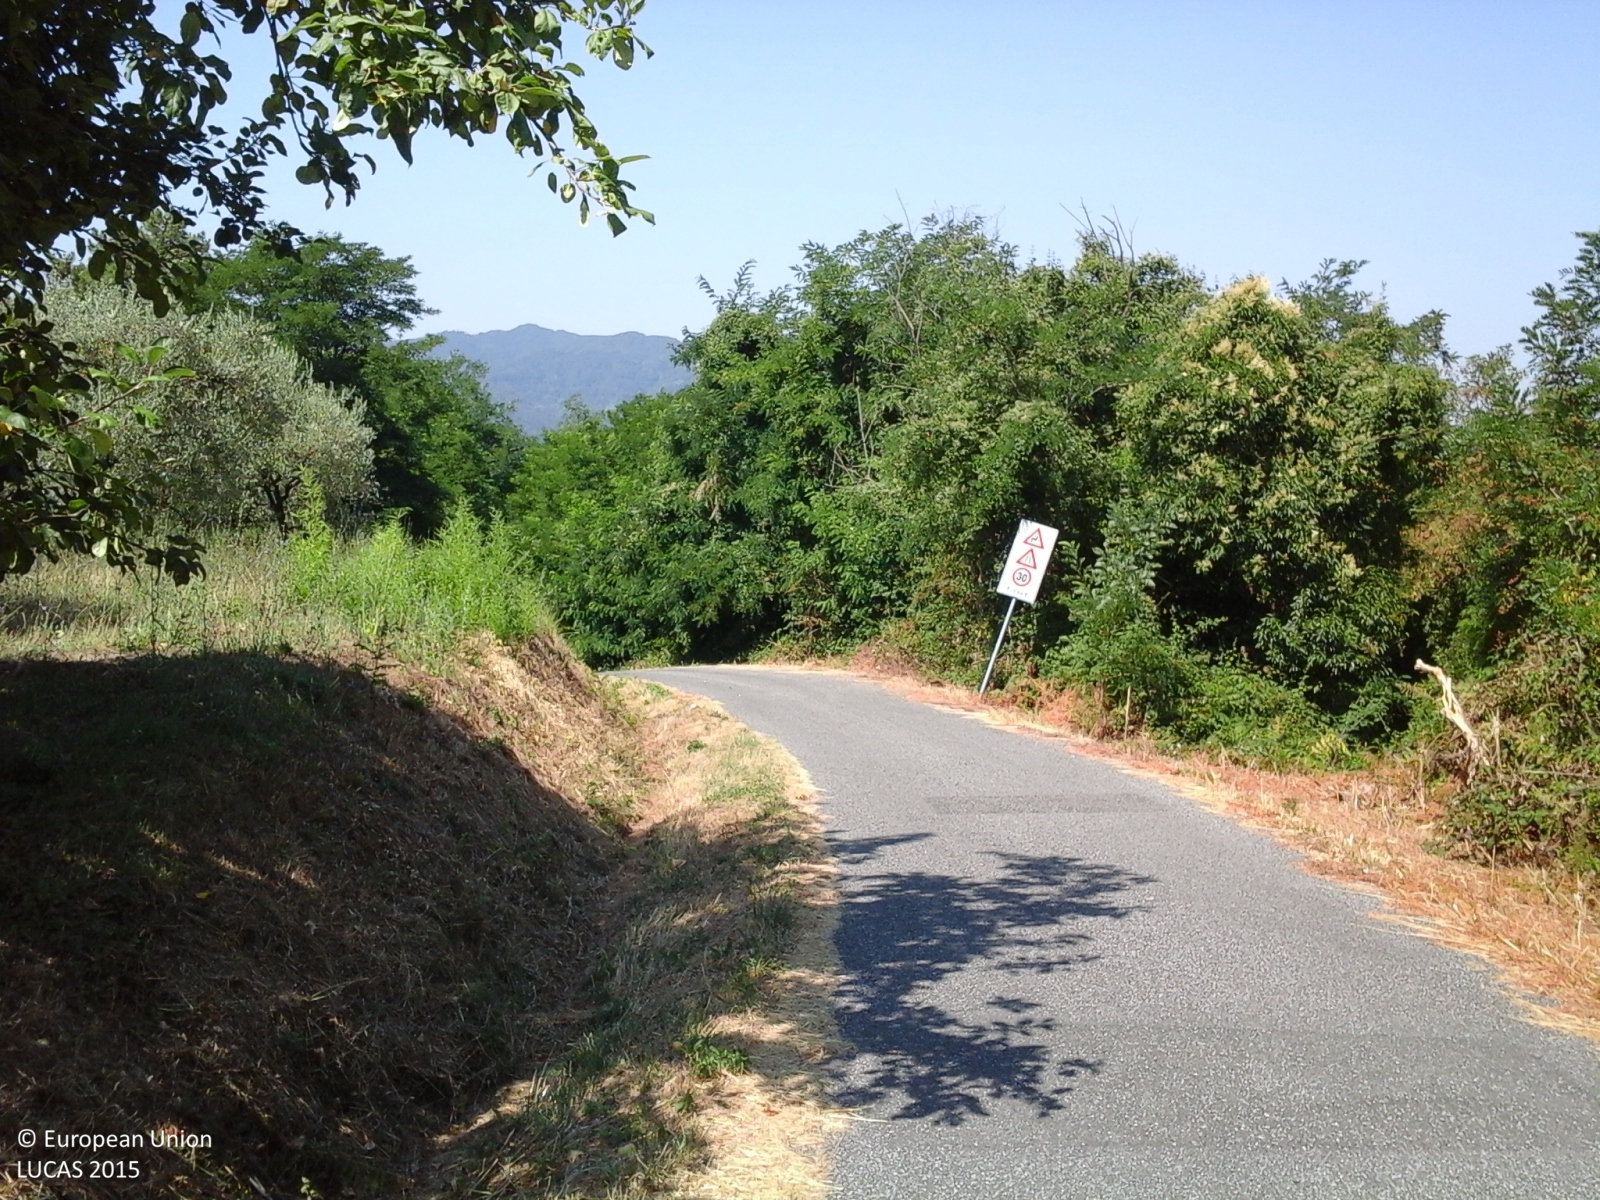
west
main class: Cropland
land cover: Olive groves
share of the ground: 25 - 50 %
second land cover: Grassland without tree/shrub cover
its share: 50 - 75 %
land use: Agriculture (excluding fallow land and kitchen gardens)
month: July
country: IT
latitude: 44.1882
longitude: 9.8877
